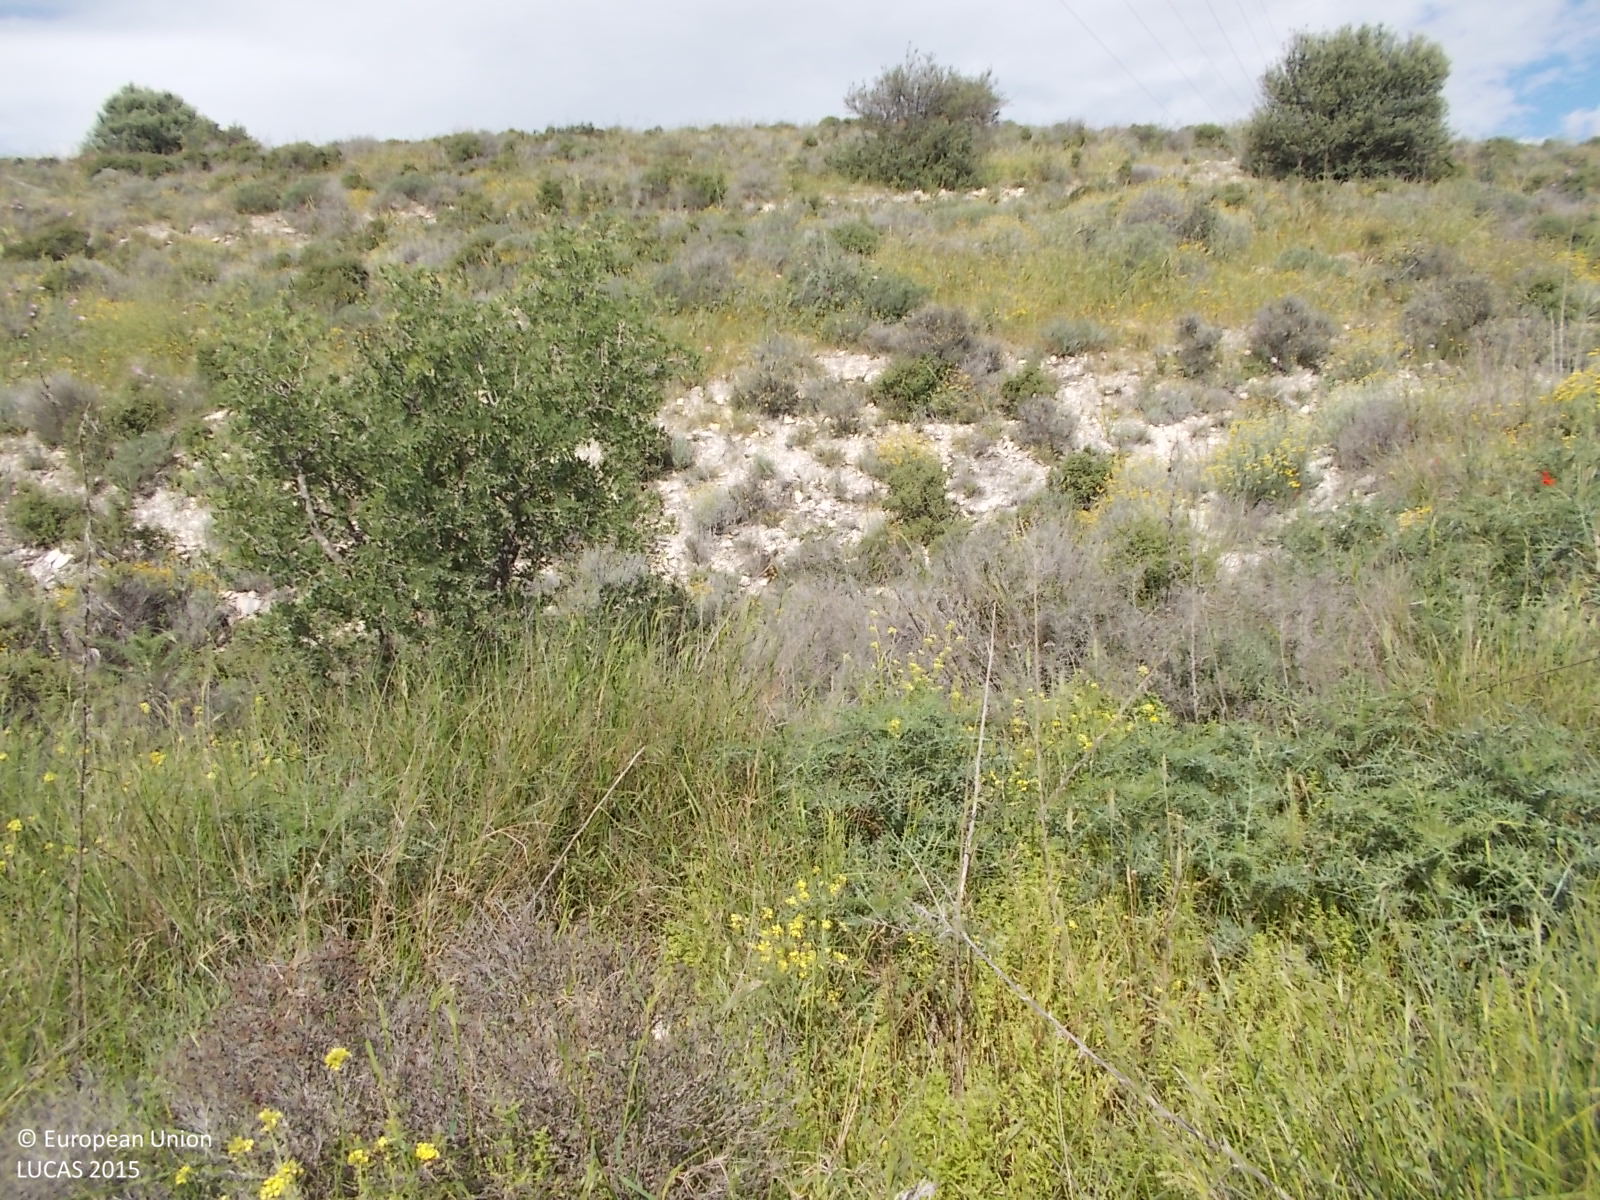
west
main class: Grassland
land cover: Grassland without tree/shrub cover
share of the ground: > 75 %
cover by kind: herbaceous plants 100 %
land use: Semi-natural and natural areas not in use
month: April
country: CY
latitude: 34.9453
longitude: 33.5036
